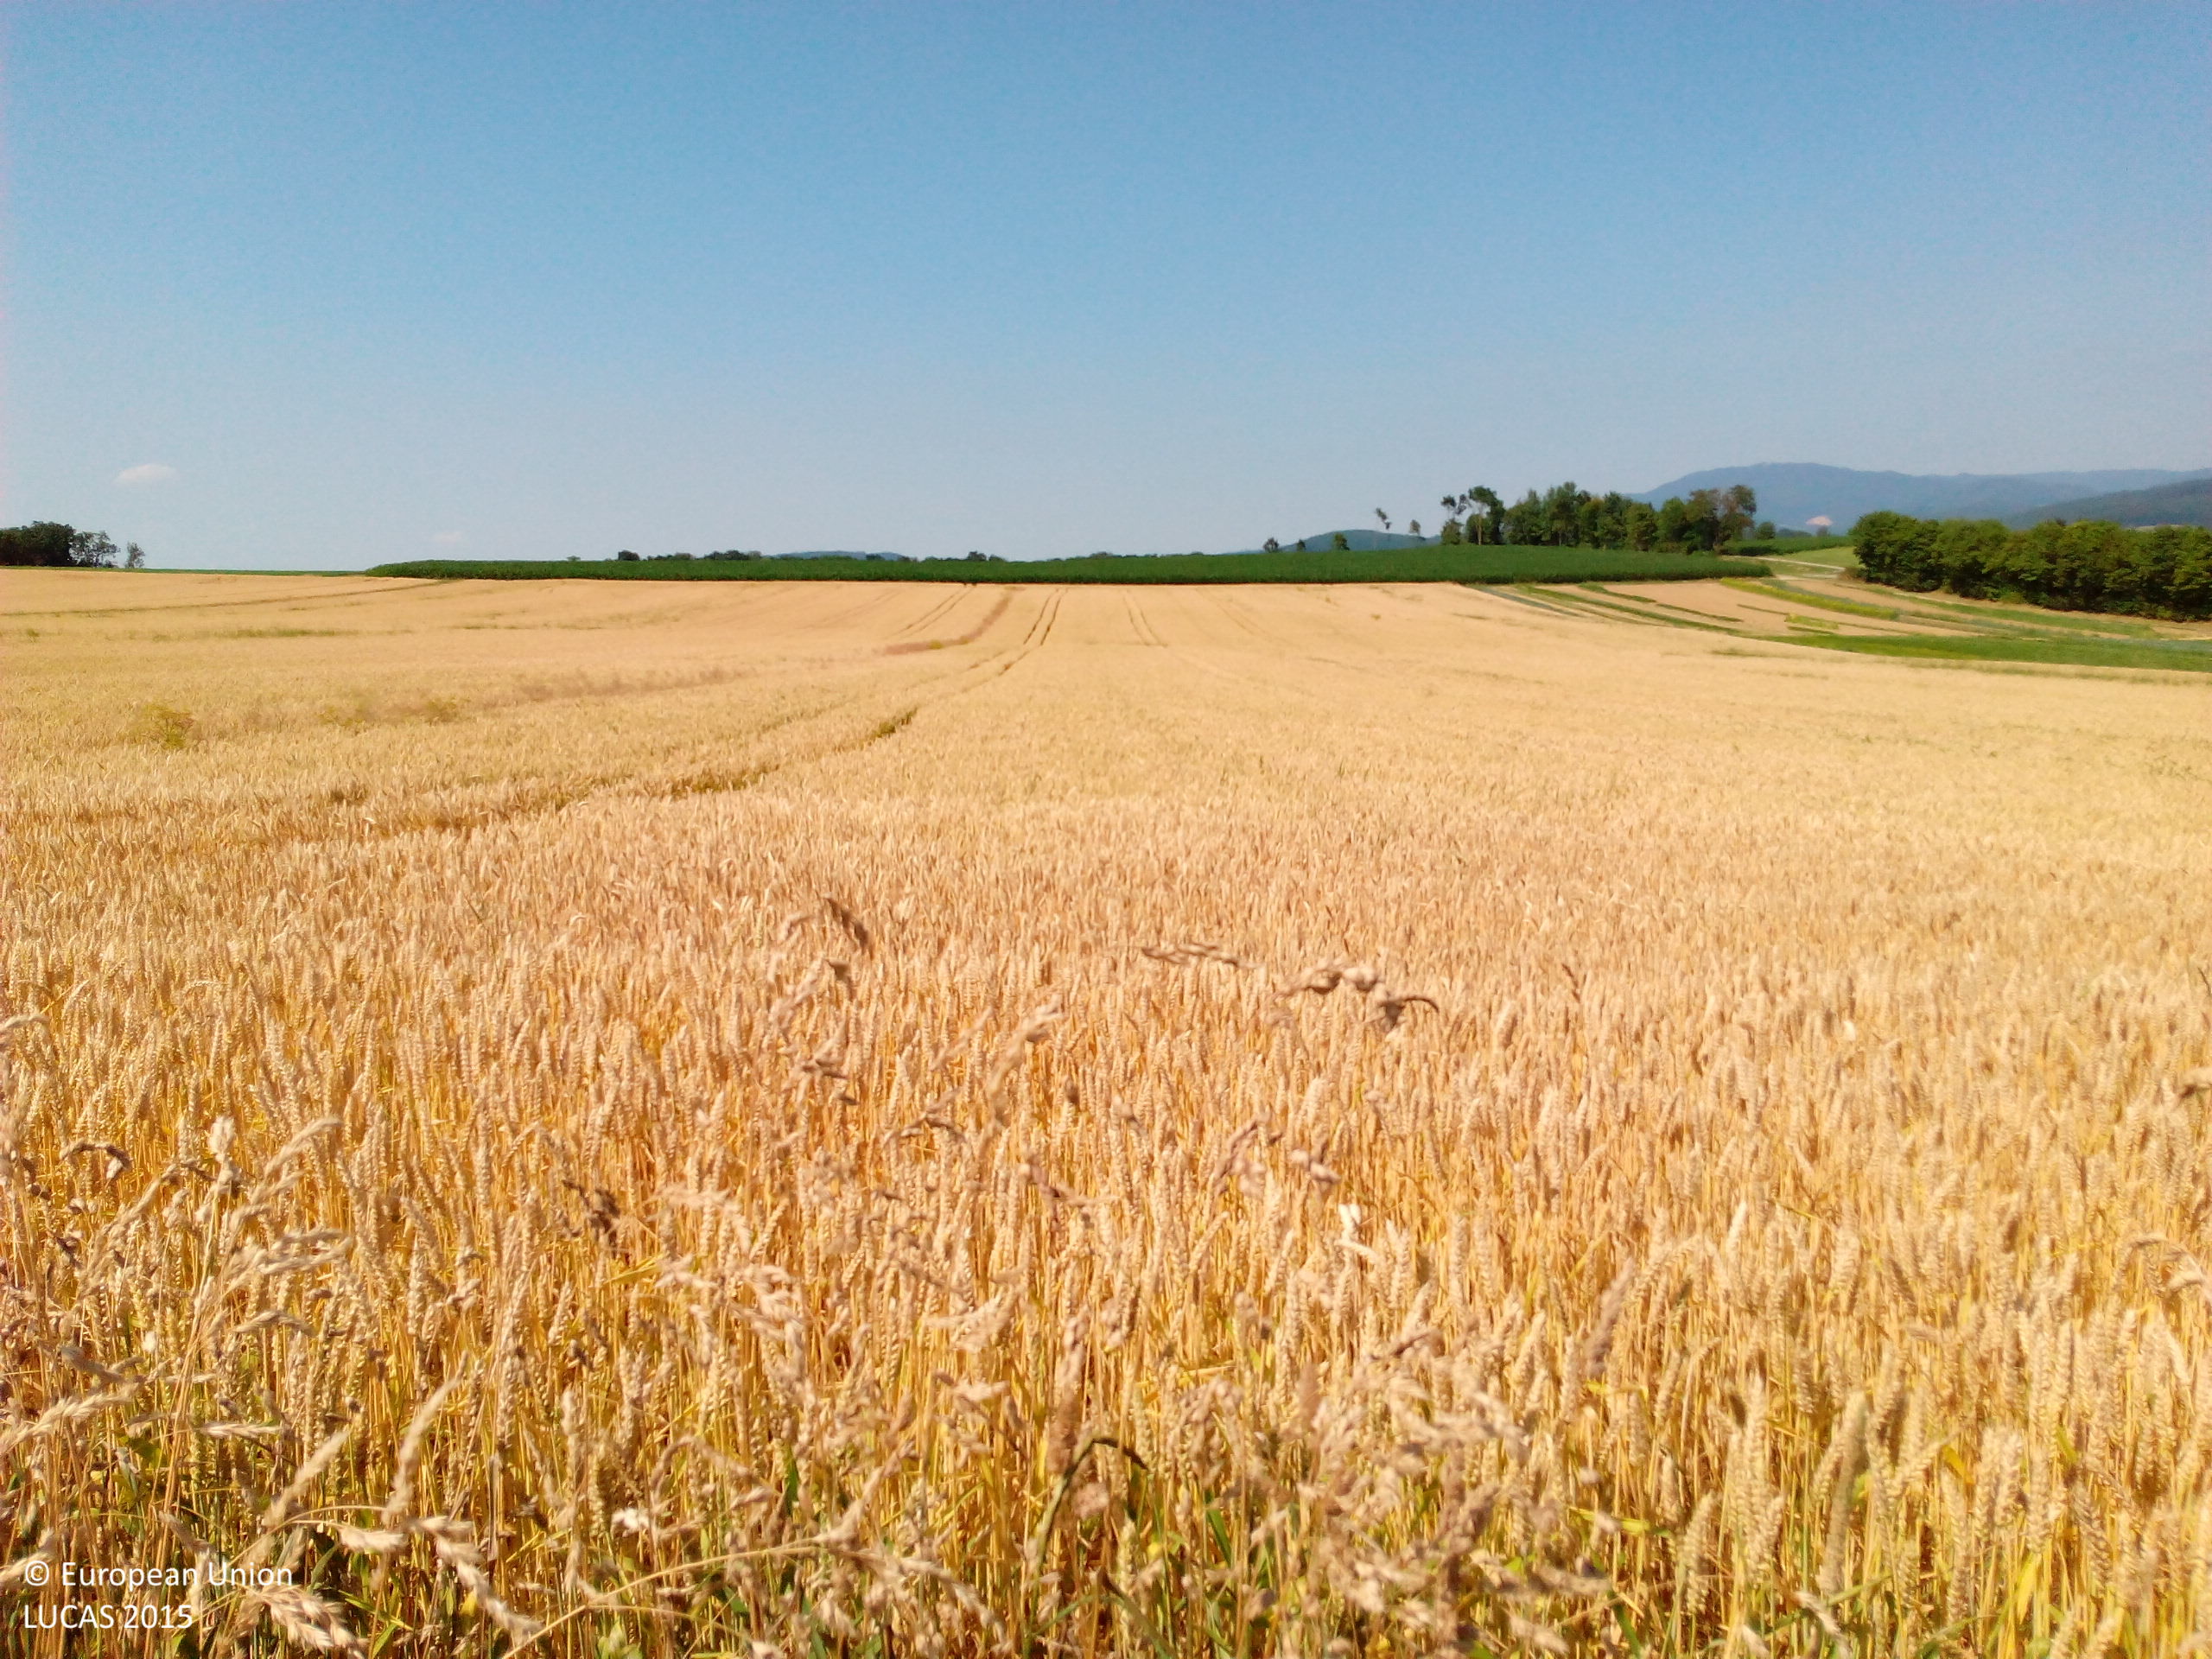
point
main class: Cropland
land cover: Common wheat
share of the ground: > 75 %
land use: Agriculture (excluding fallow land and kitchen gardens)
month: July
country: DE
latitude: 47.6577
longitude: 7.6181
